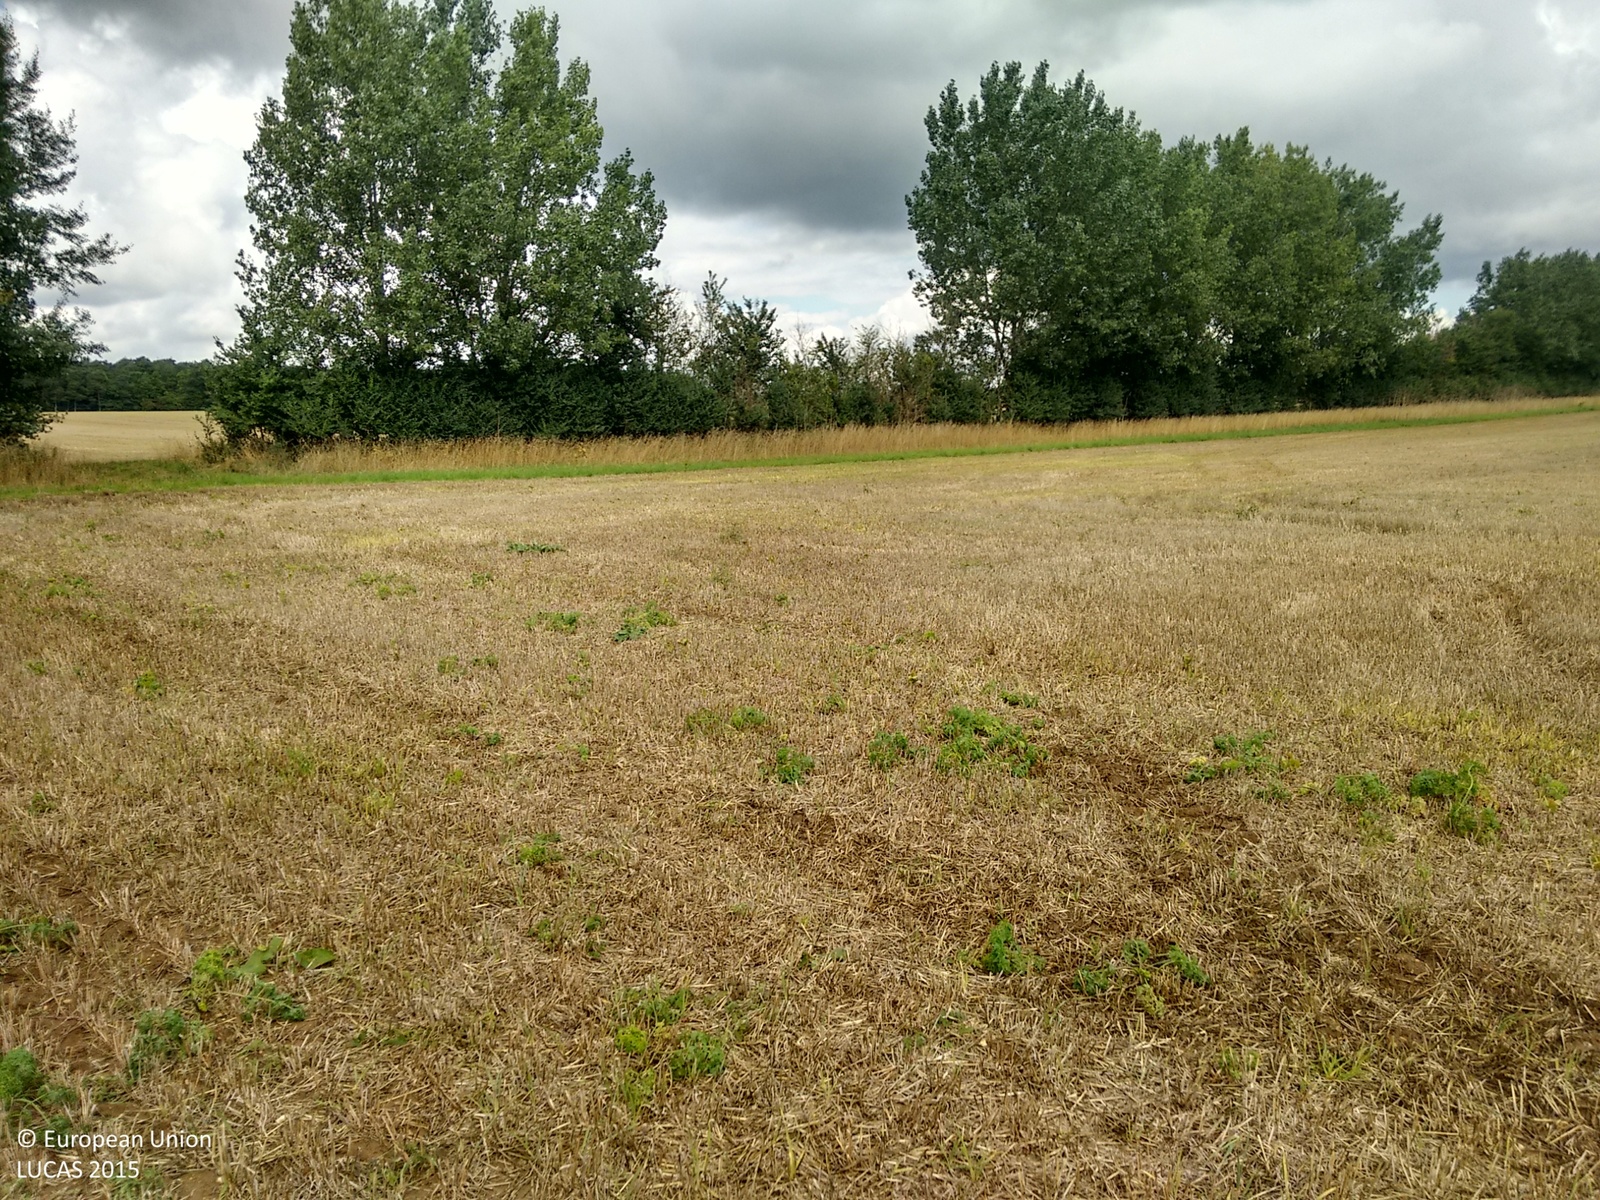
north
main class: Cropland
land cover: Barley
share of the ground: > 75 %
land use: Agriculture (excluding fallow land and kitchen gardens)
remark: Harvested field
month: September
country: GB
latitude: 52.2797
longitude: 0.4296
